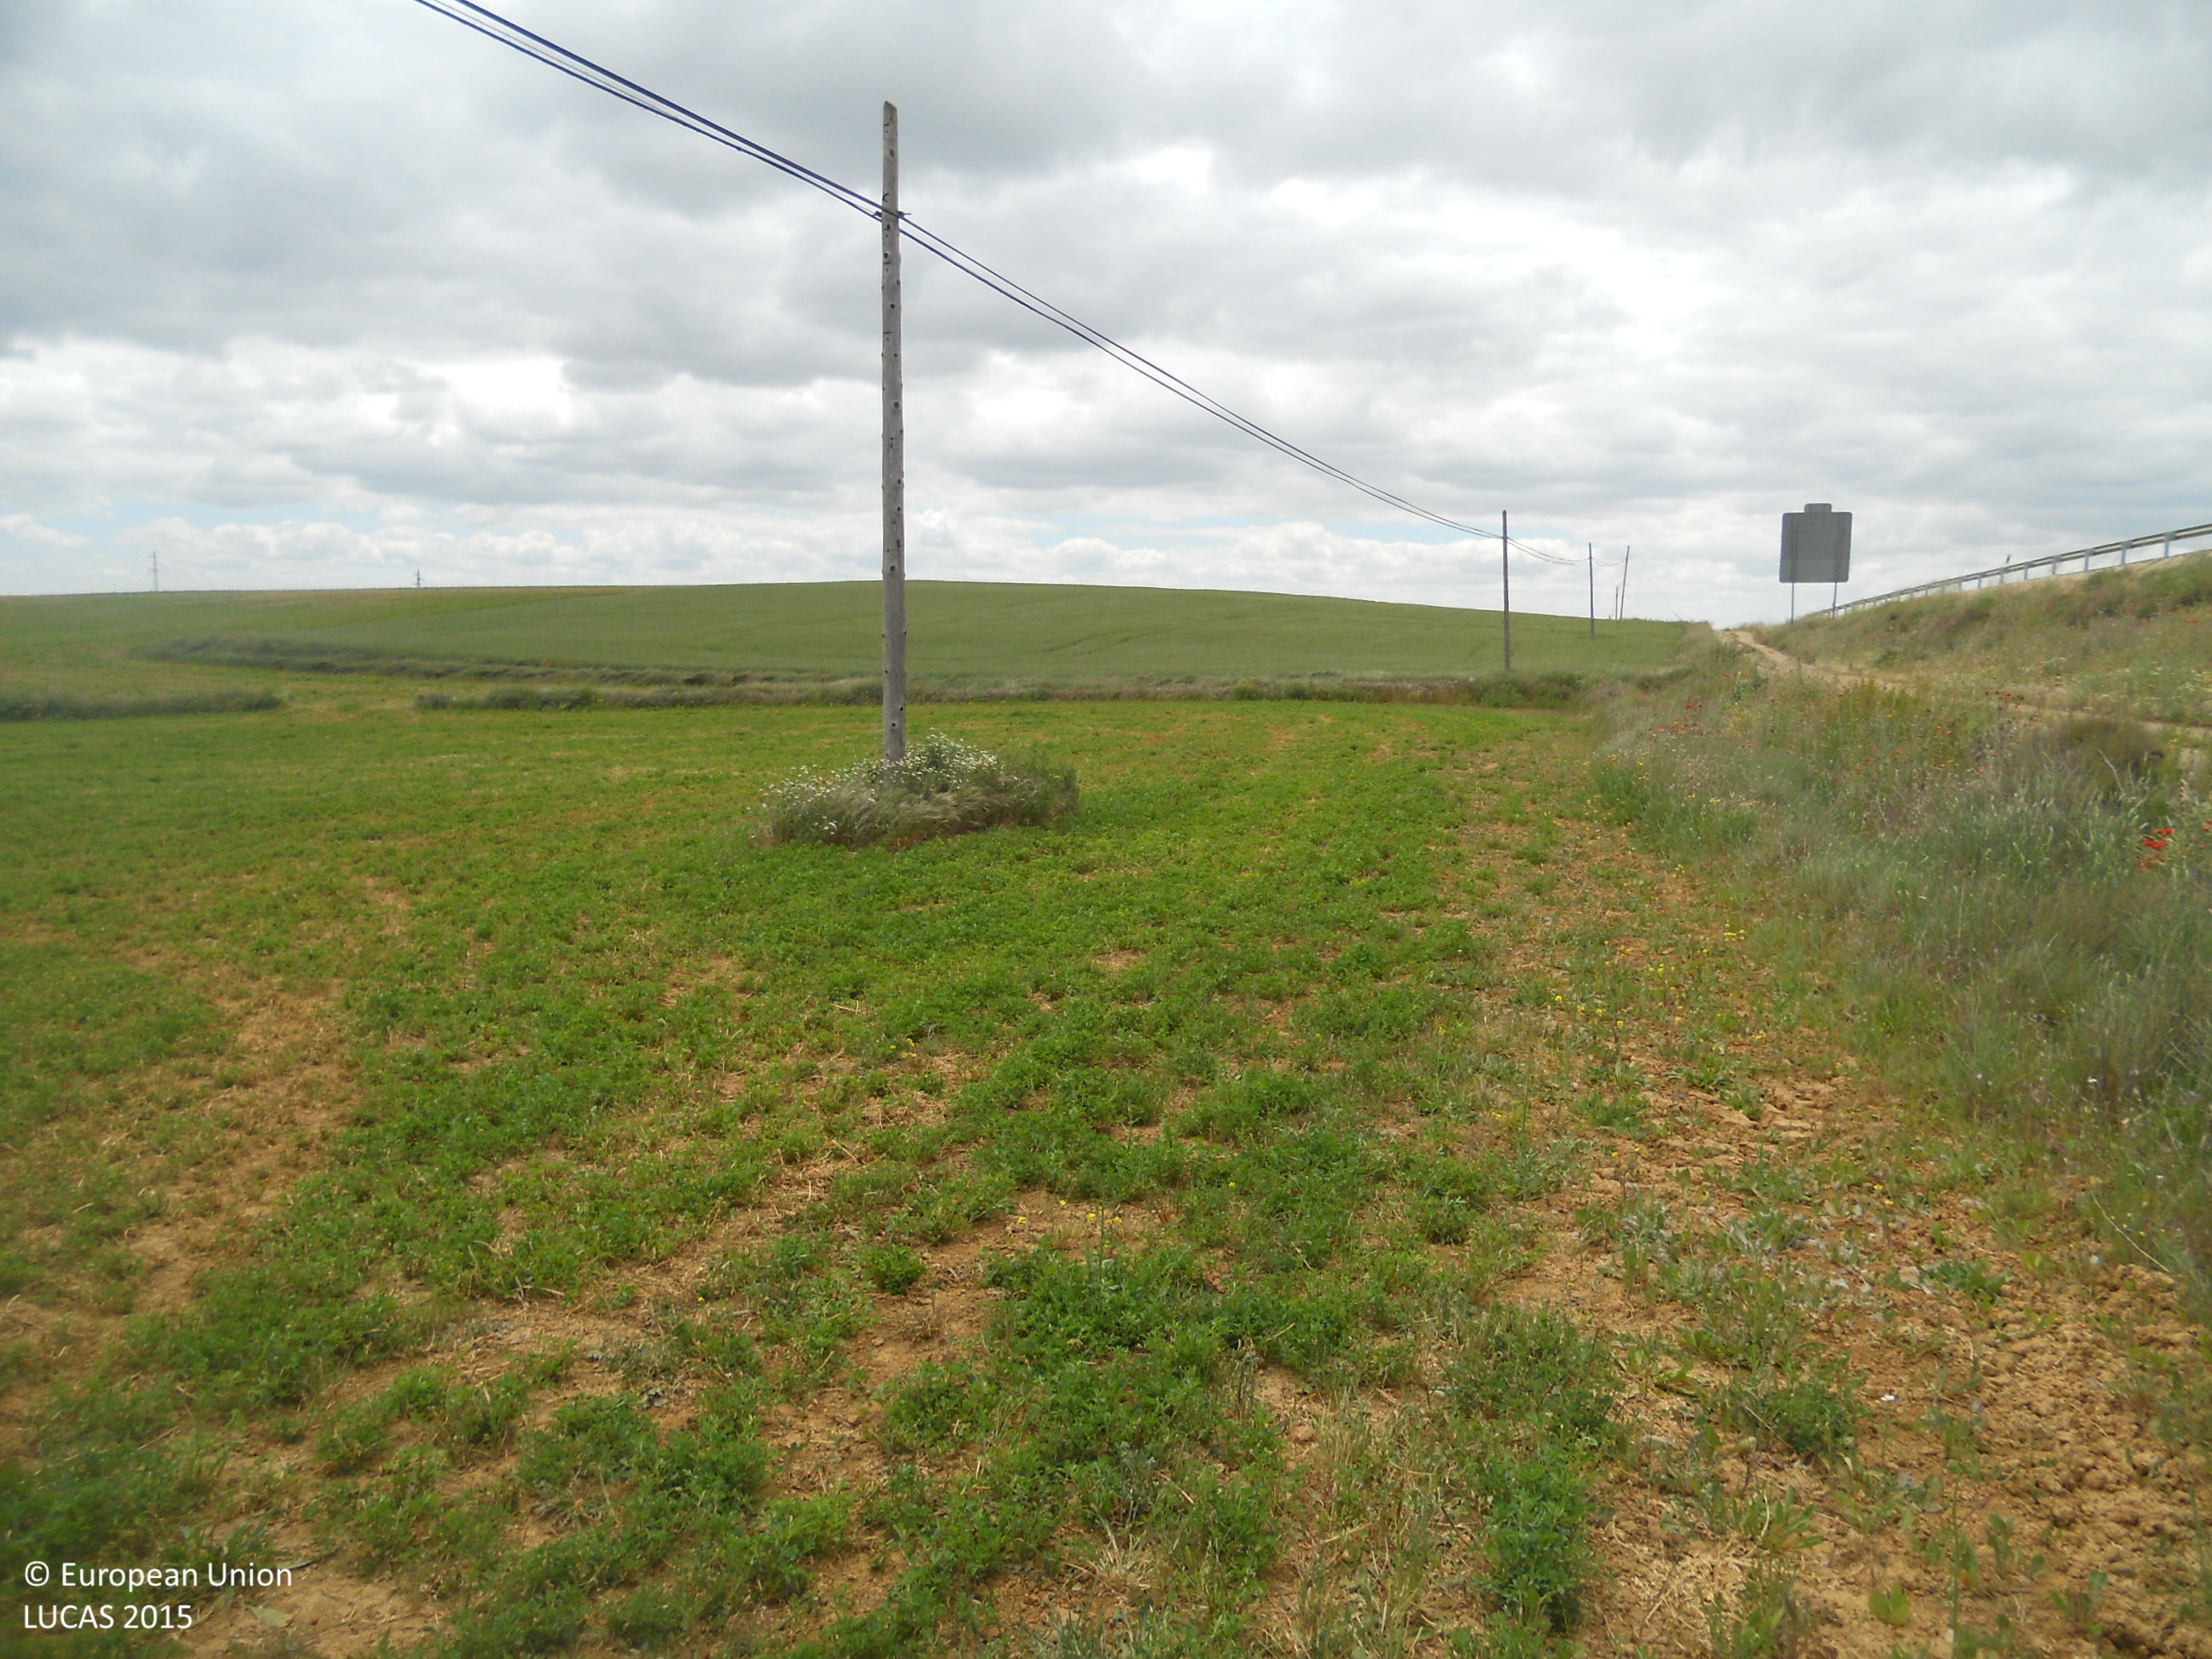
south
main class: Cropland
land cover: Lucerne
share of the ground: > 75 %
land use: Agriculture (excluding fallow land and kitchen gardens)
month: May
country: ES
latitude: 42.3925
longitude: -4.3698
